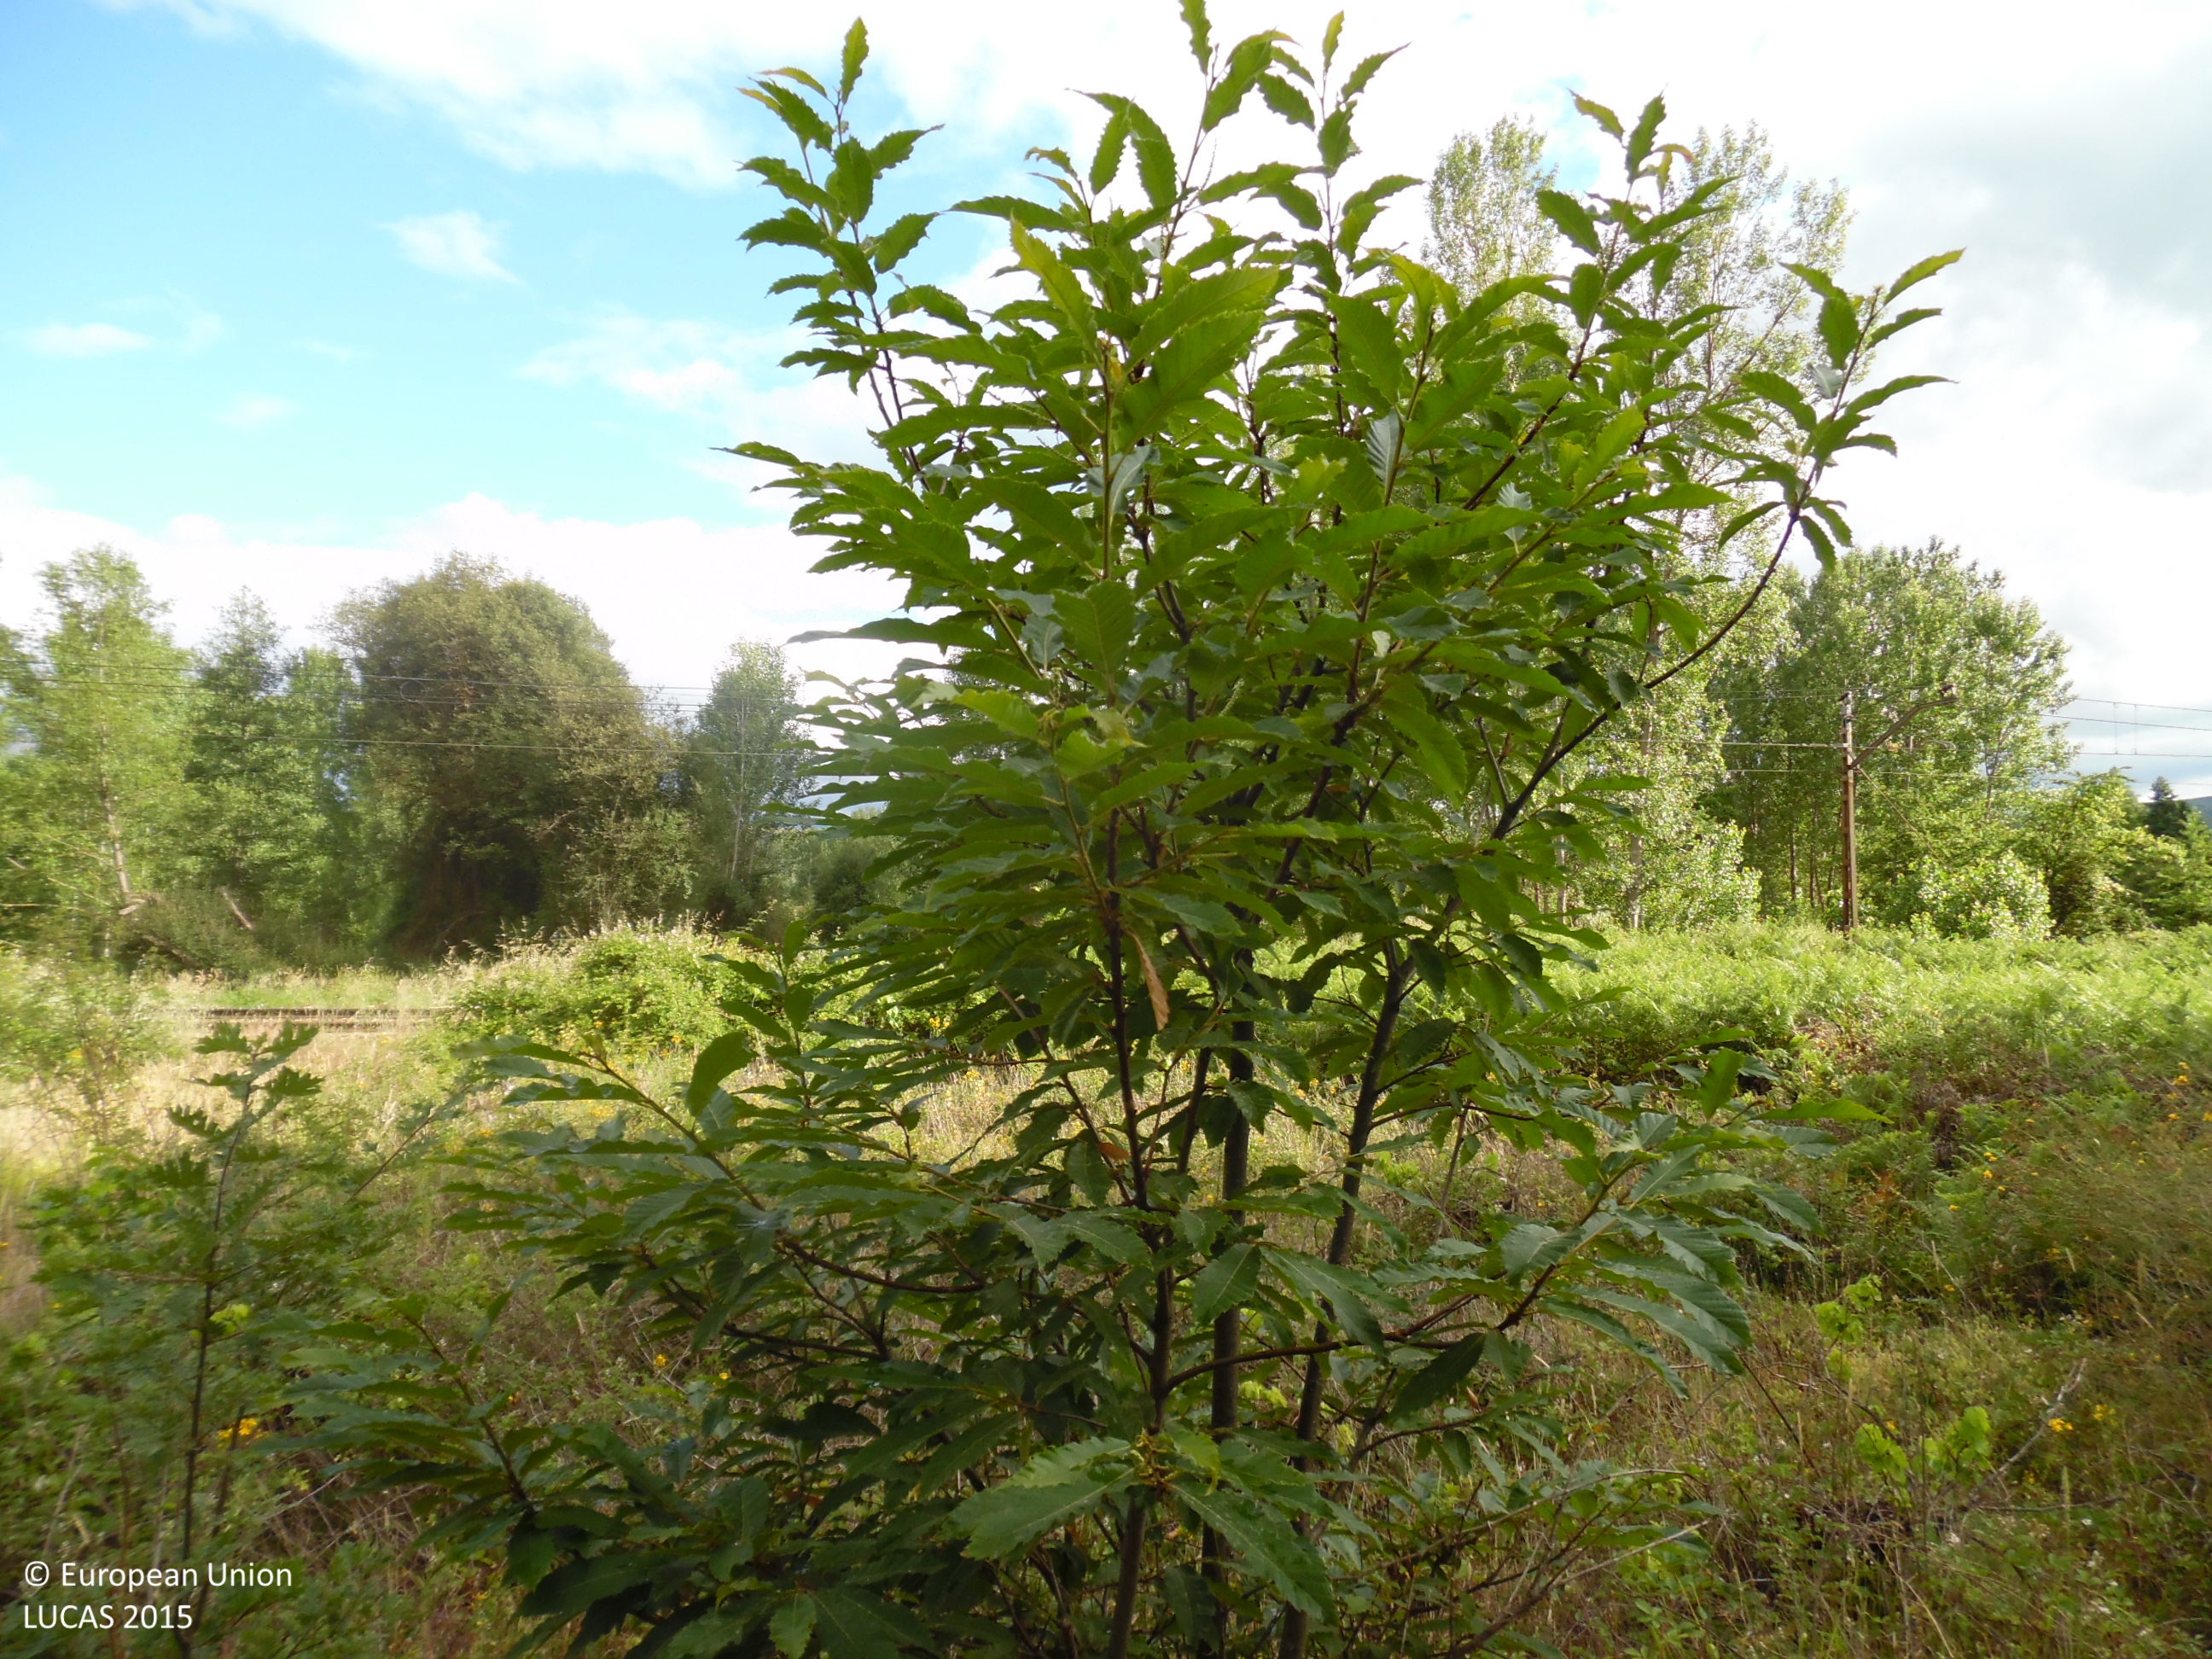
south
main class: Shrubland
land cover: Shrubland with sparse tree cover
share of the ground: > 75 %
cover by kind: shrubs 95 %, broadleaved forest trees 5 %
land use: Abandoned areas
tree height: > 5 m
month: June
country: ES
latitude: 42.5369
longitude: -6.7428
